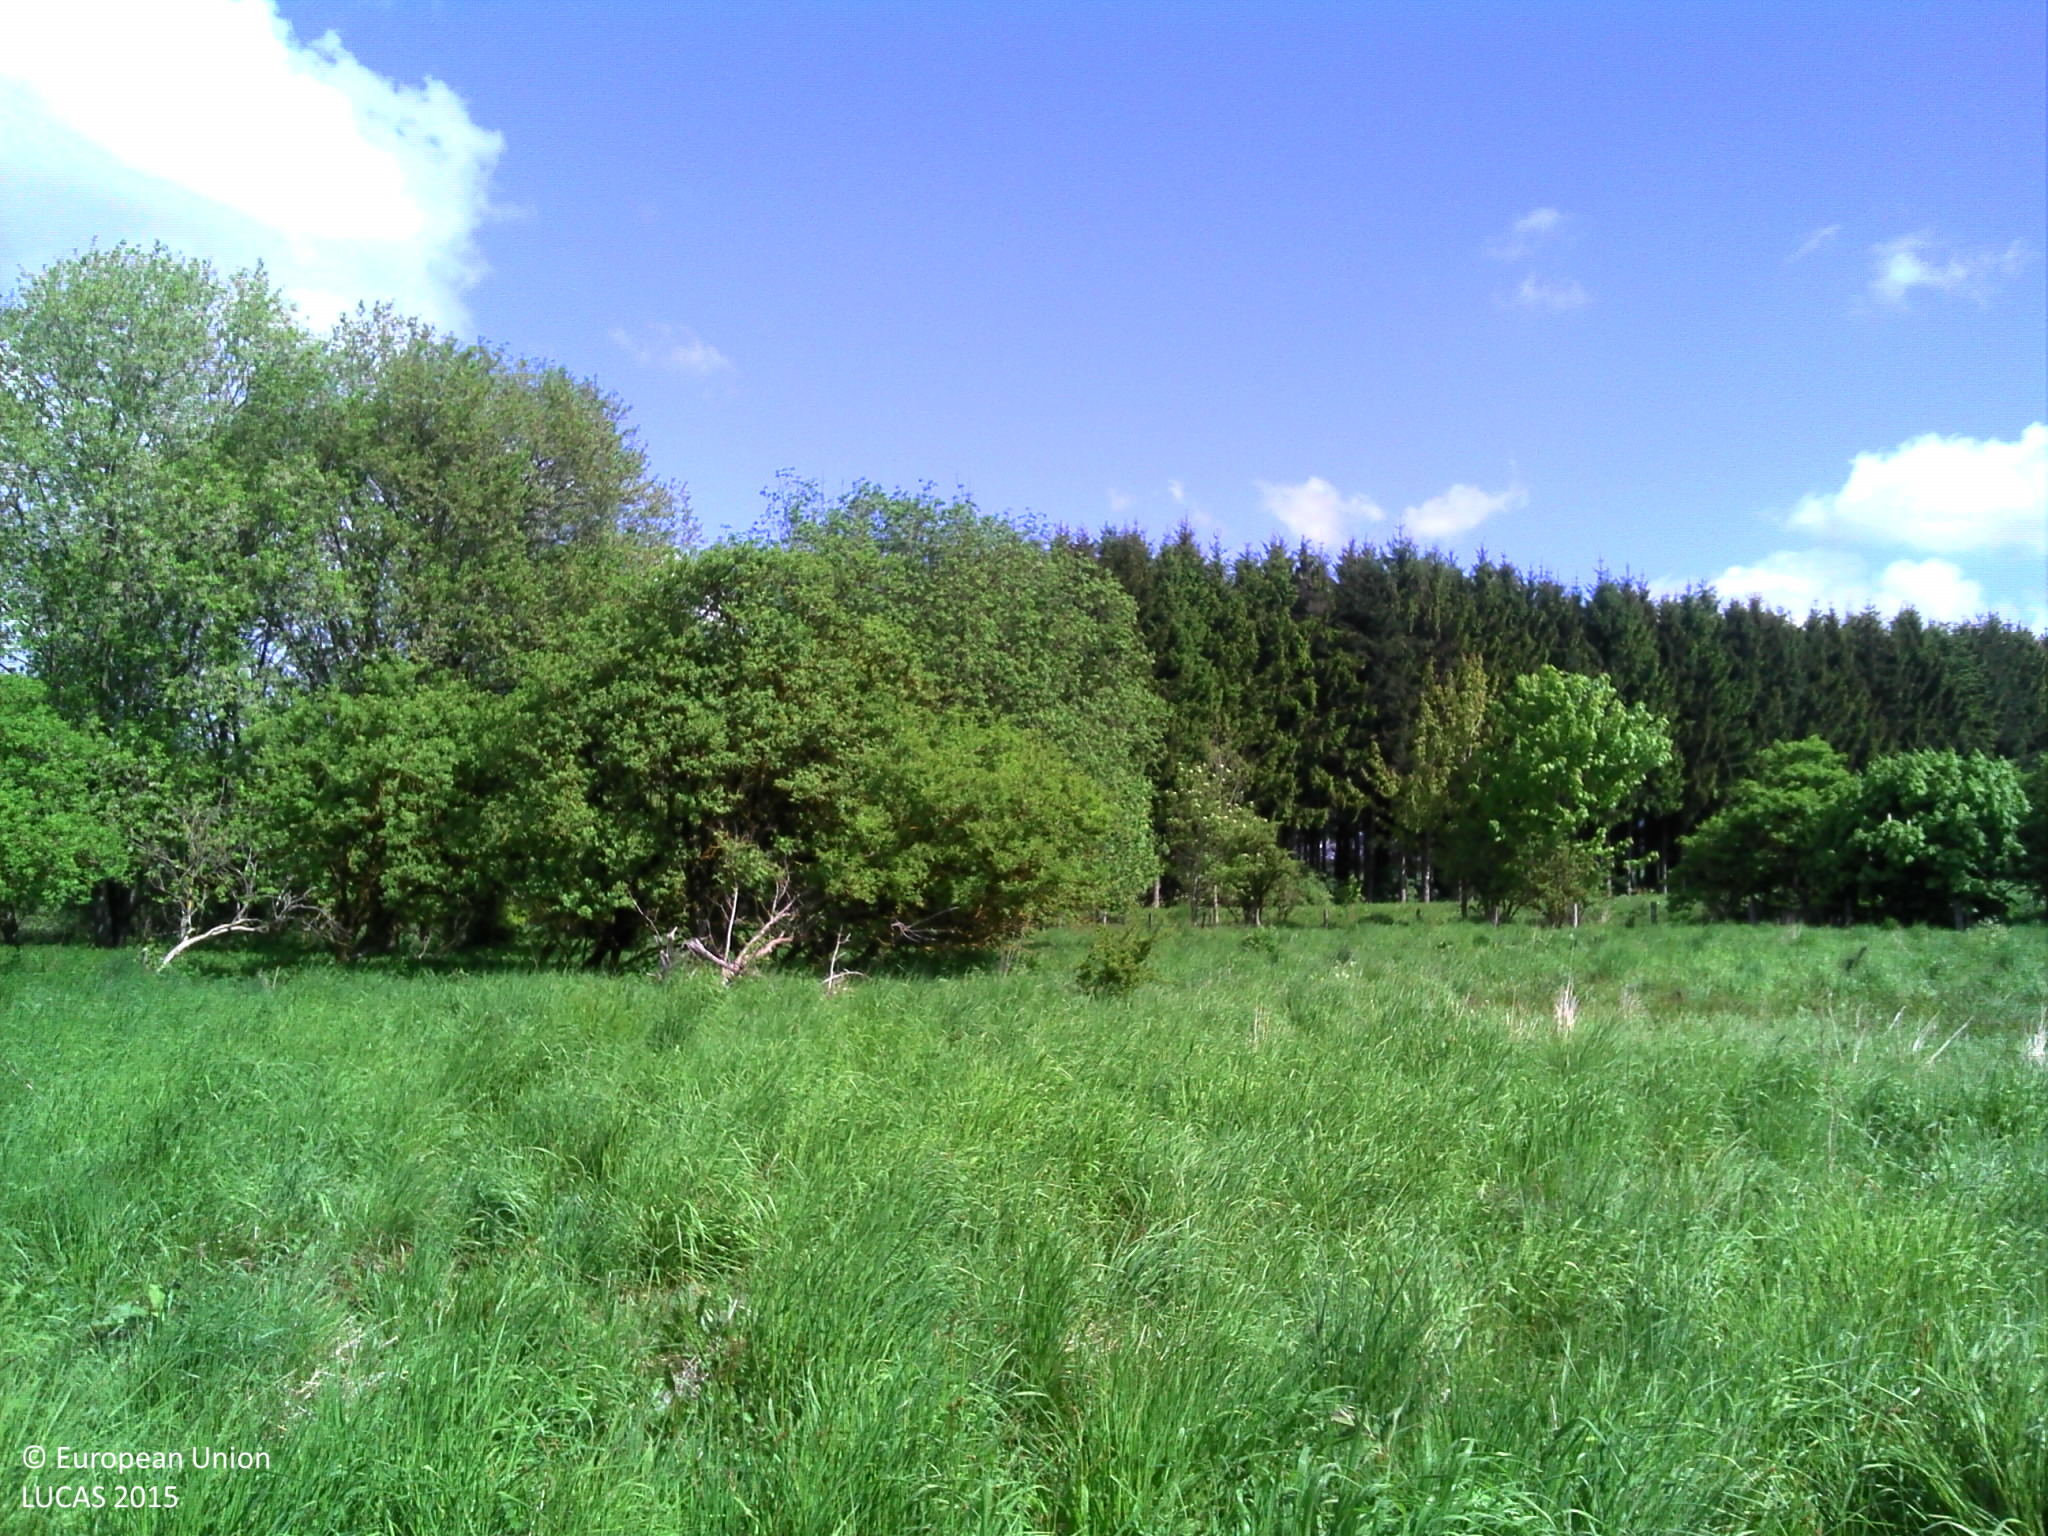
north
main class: Grassland
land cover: Grassland with sparse tree/shrub cover
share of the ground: > 75 %
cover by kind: herbaceous plants 95 %, broadleaved forest trees 5 %
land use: Agriculture (excluding fallow land and kitchen gardens)
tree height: > 5 m
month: May
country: LU
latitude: 50.1675
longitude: 5.9811
